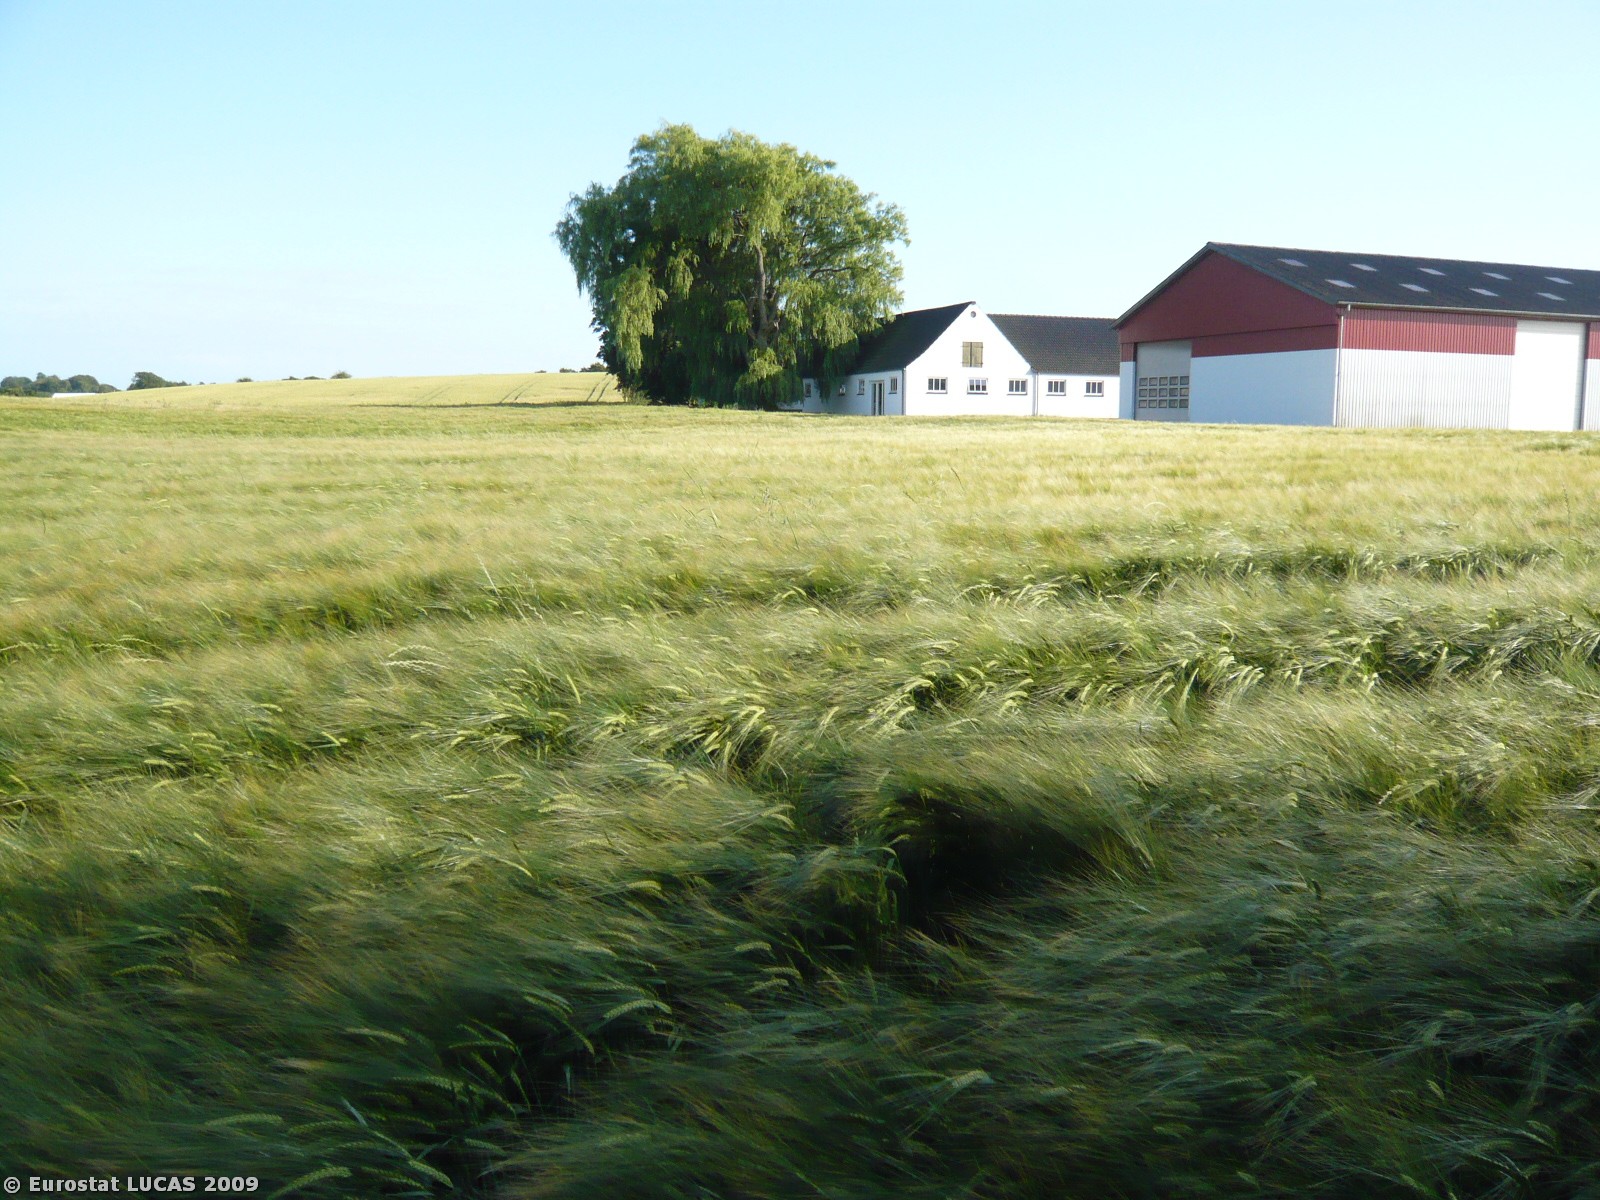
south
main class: Woodland
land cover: Broadleaved woodland
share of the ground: > 75 %
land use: Residential
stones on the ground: < 10 %
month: July
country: DK
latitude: 55.5691
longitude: 11.3784
